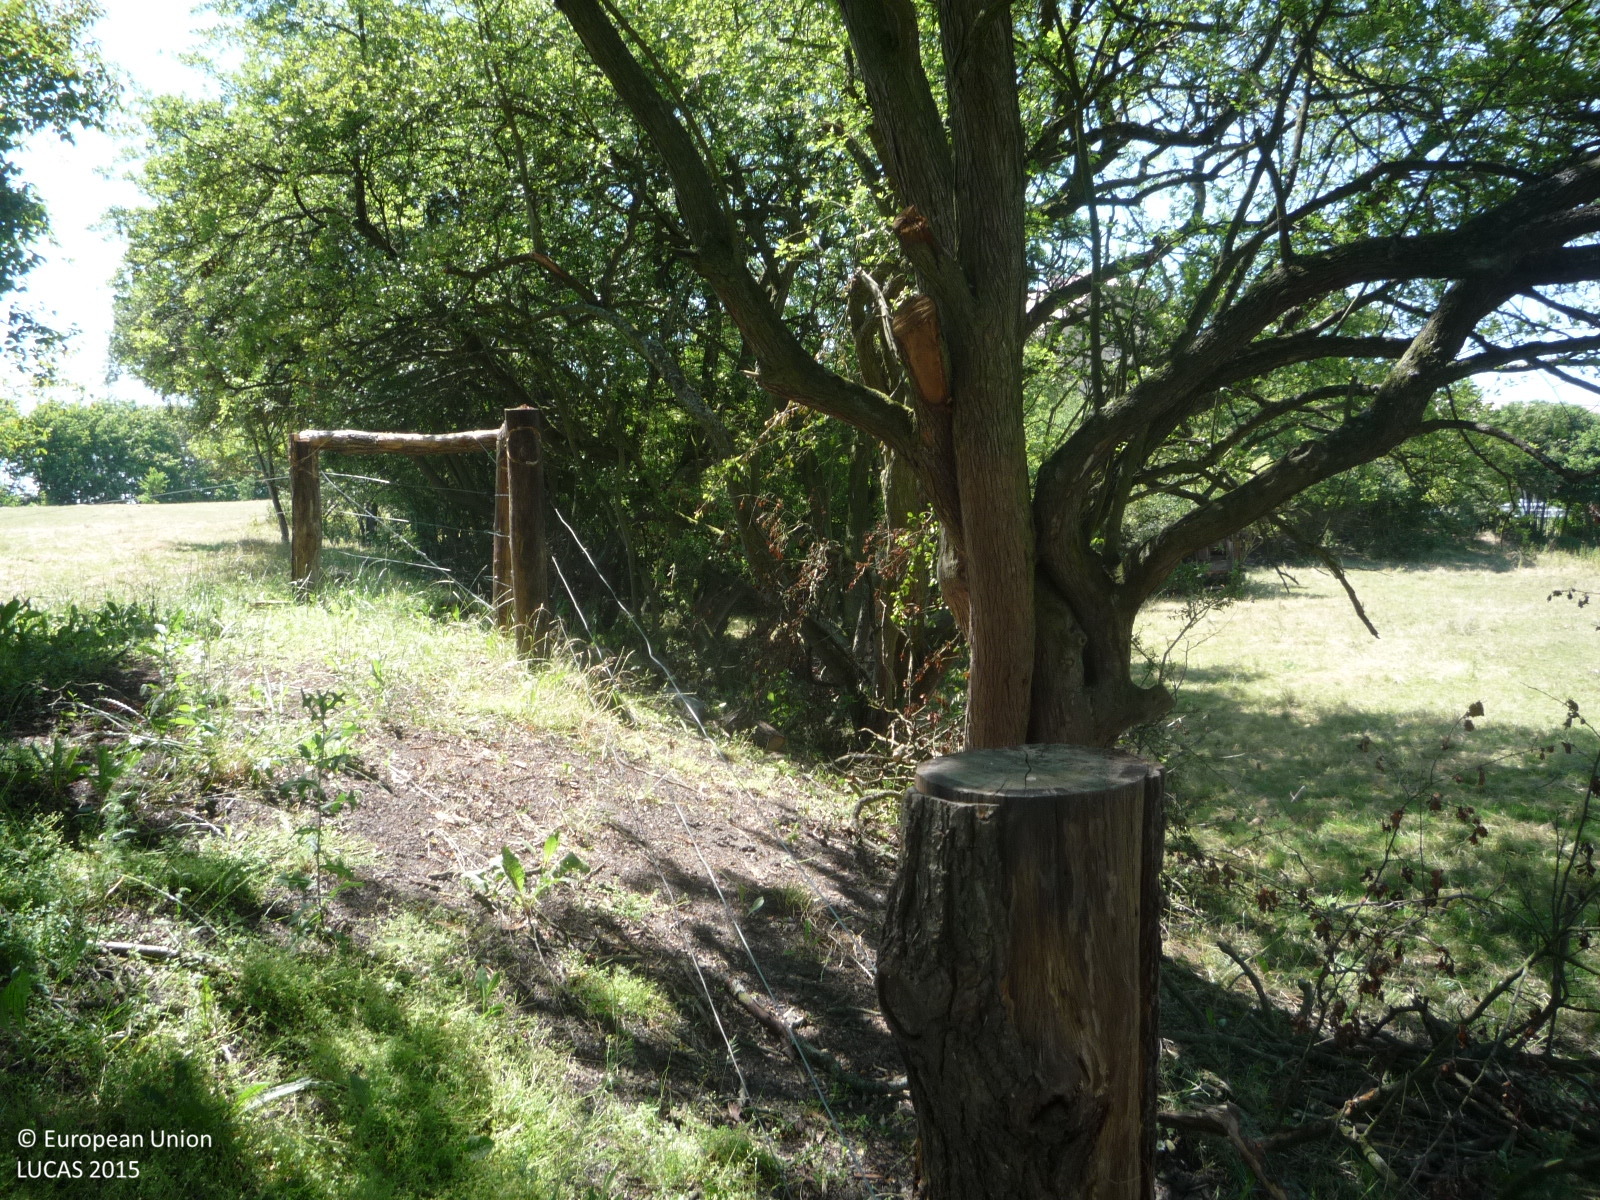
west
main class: Grassland
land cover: Grassland without tree/shrub cover
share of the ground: > 75 %
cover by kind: herbaceous plants 100 %
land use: Agriculture (excluding fallow land and kitchen gardens)
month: July
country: CZ
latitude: 50.2789
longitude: 15.2657
